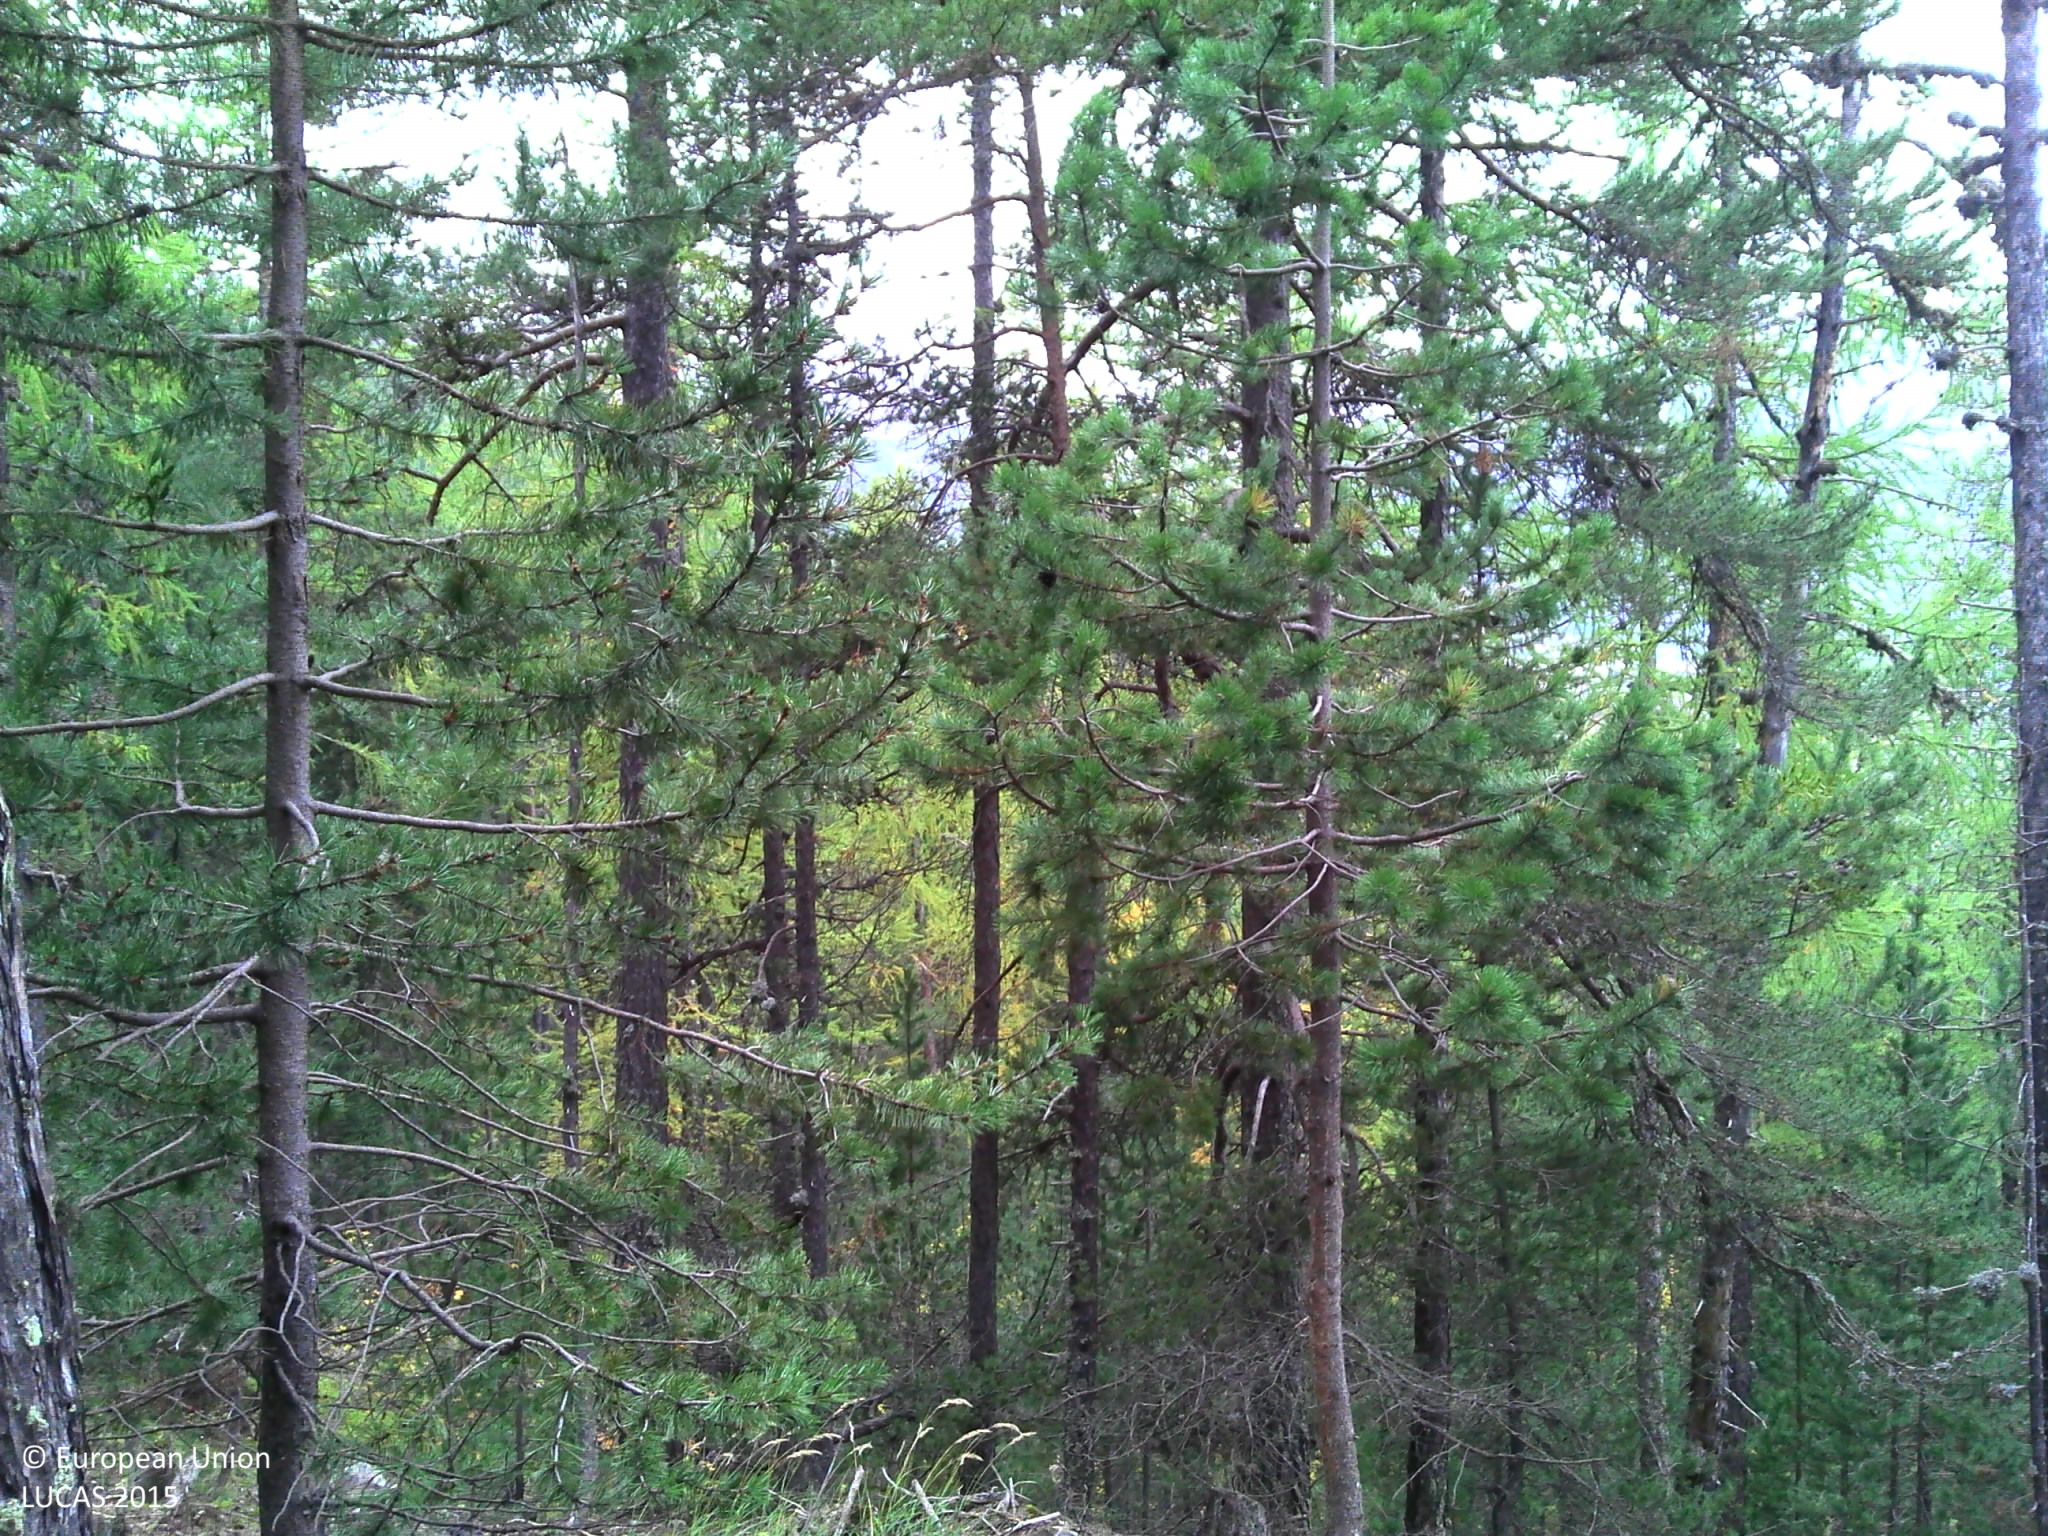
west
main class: Woodland
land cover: Pine dominated coniferous woodland
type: alpine coniferous forest
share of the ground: > 75 %
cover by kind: coniferous forest trees 70 %, unconsolidated bare surface 20 %, shrubs 5 %, lichens and mosses 5 %
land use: Forestry
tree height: > 5 m
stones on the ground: 10 - 25 %
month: October
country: FR
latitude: 44.8159
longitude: 6.5283
